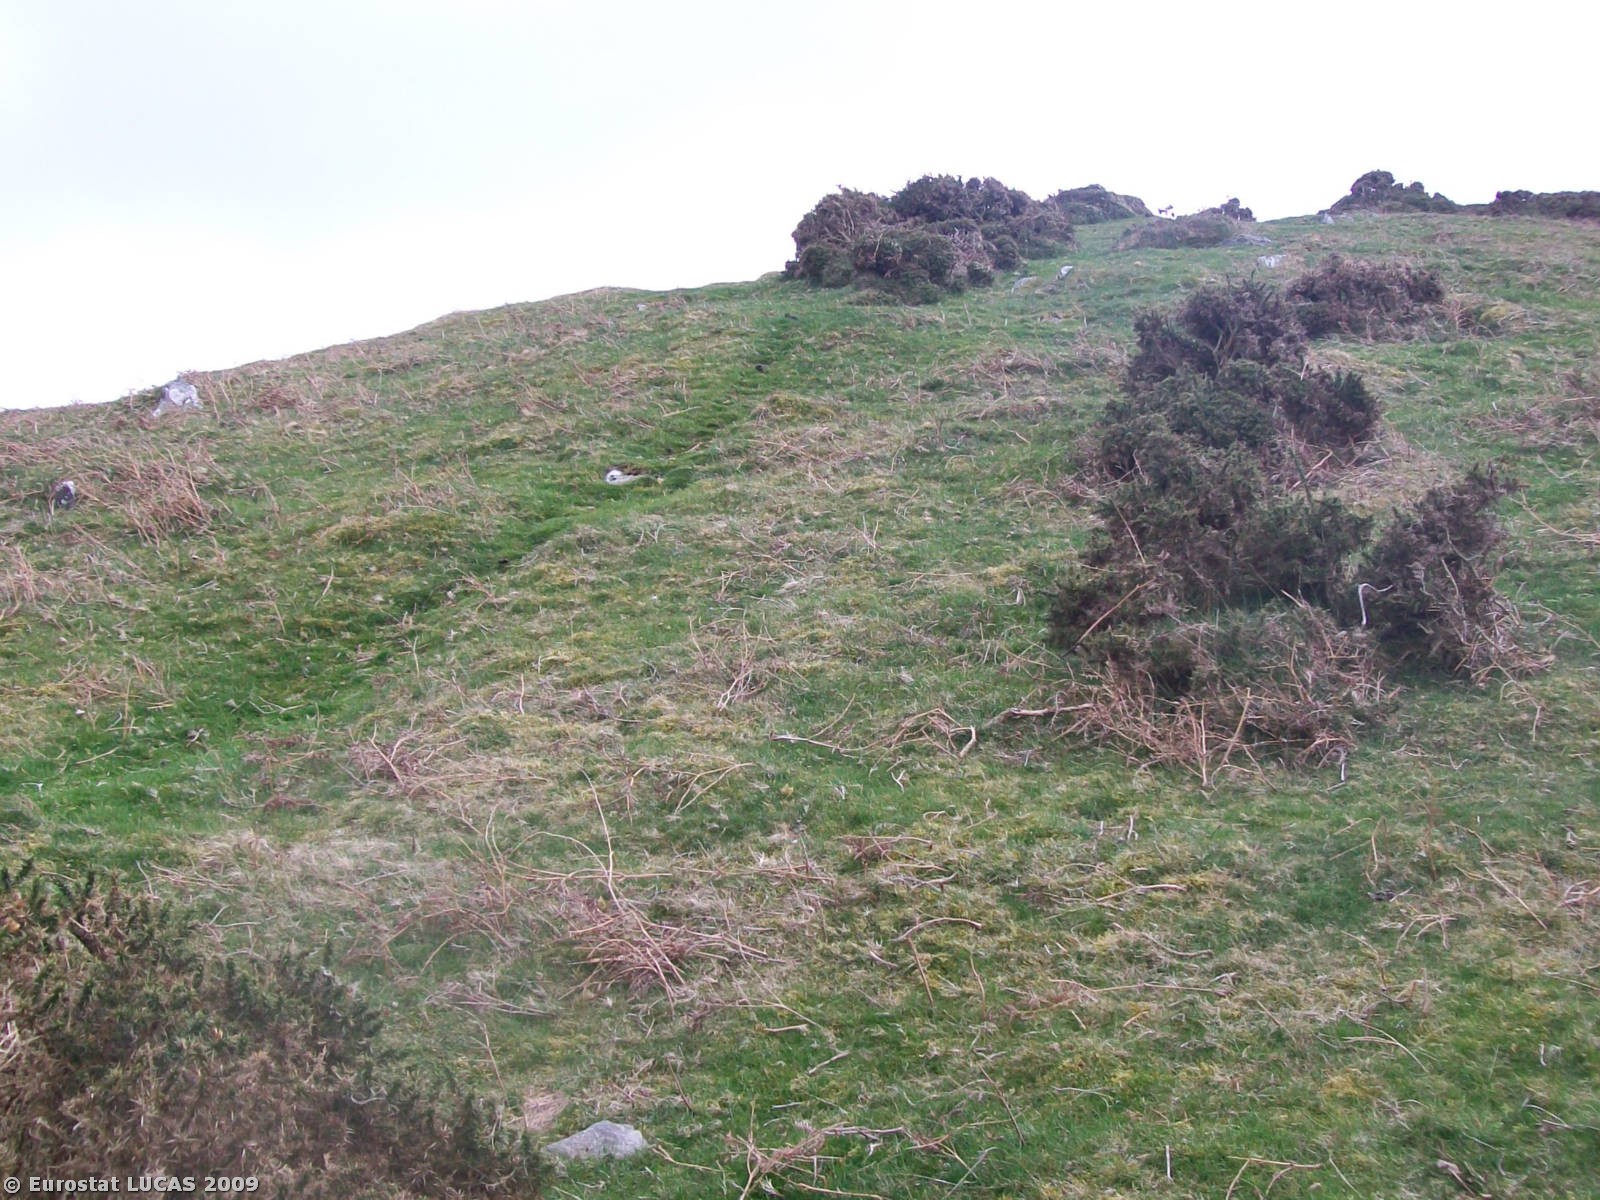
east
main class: Shrubland
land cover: Shrubland without tree cover
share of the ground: > 75 %
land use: Agriculture (excluding fallow land and kitchen gardens)
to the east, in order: Shrubland without tree cover
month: April
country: GB
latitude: 53.2252
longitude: -3.3369
